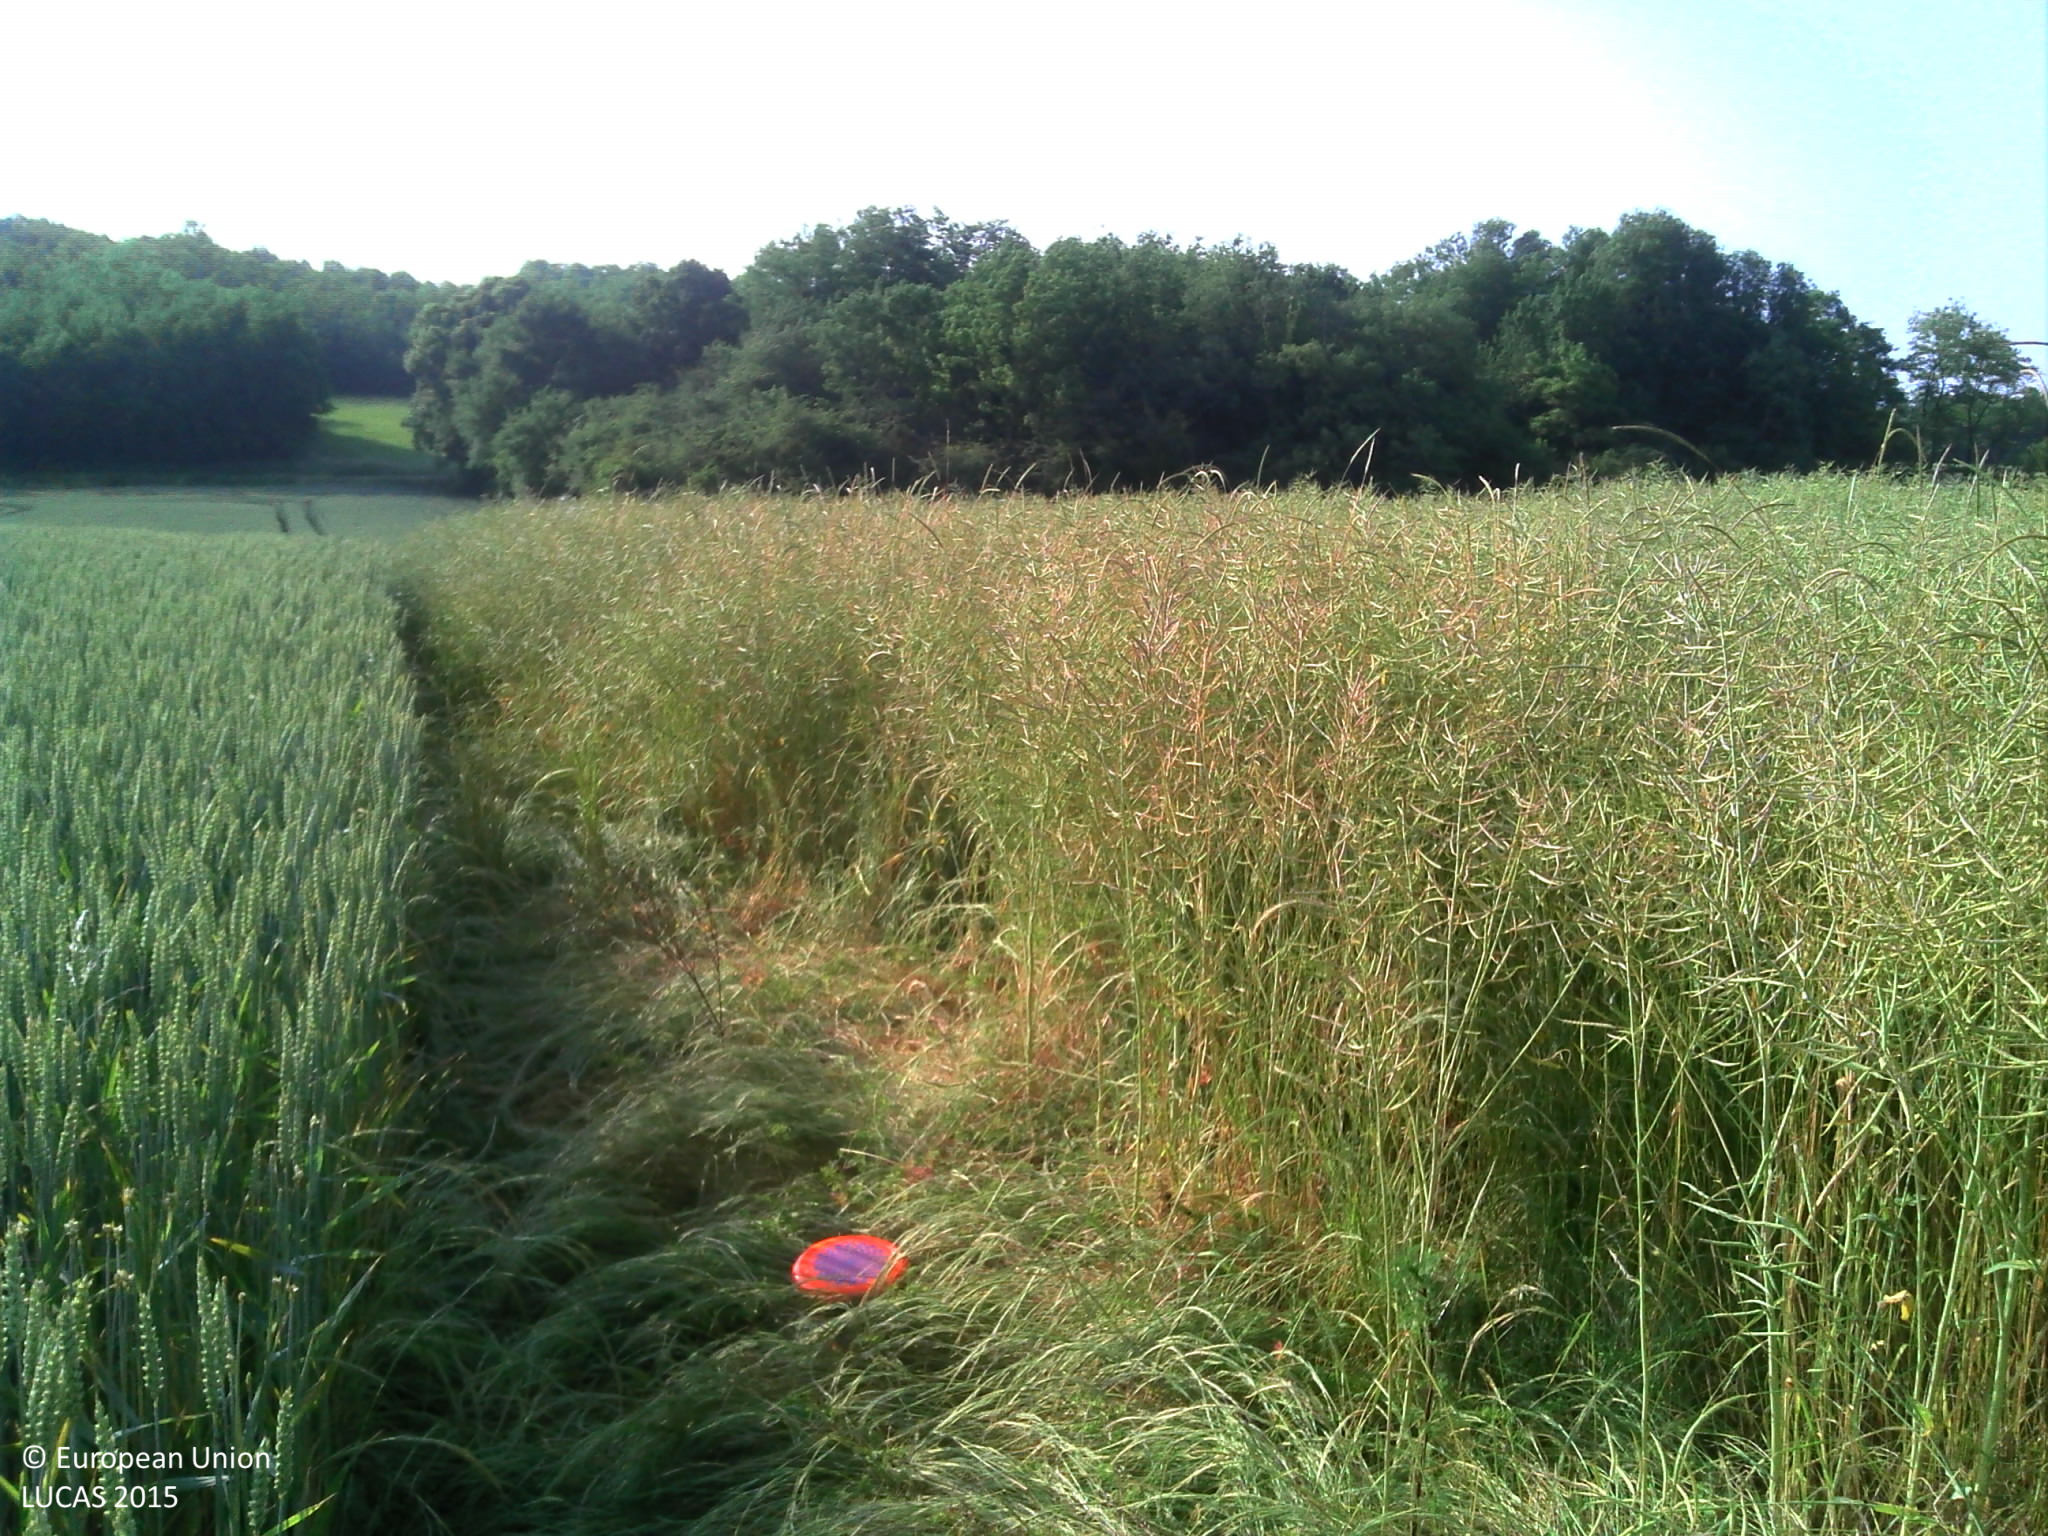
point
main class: Cropland
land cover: Rape and turnip rape
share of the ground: > 75 %
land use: Agriculture (excluding fallow land and kitchen gardens)
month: June
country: FR
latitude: 46.5173
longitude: 4.8794
